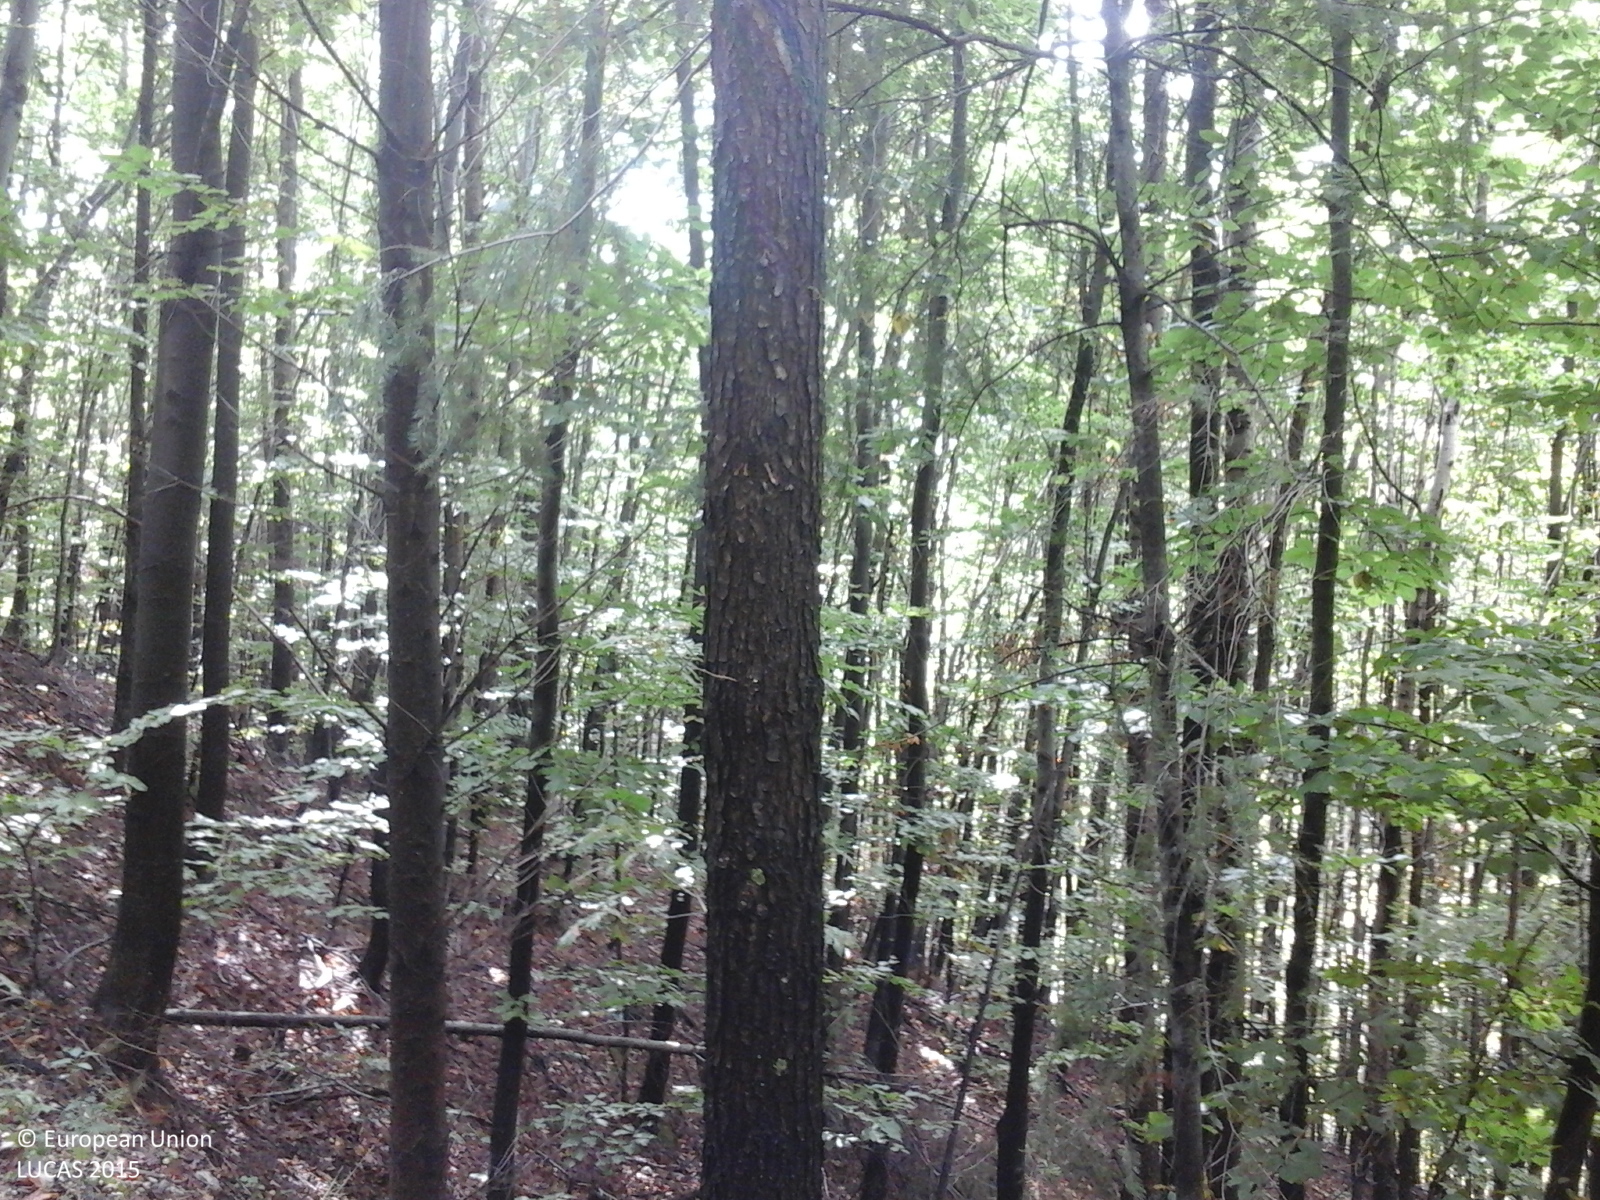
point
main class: Woodland
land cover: Other mixed woodland
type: beech forest
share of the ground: > 75 %
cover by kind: broadleaved forest trees 75 %, coniferous forest trees 25 %
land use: Forestry
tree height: > 5 m
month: September
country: RO
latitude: 45.1958
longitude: 24.4733
